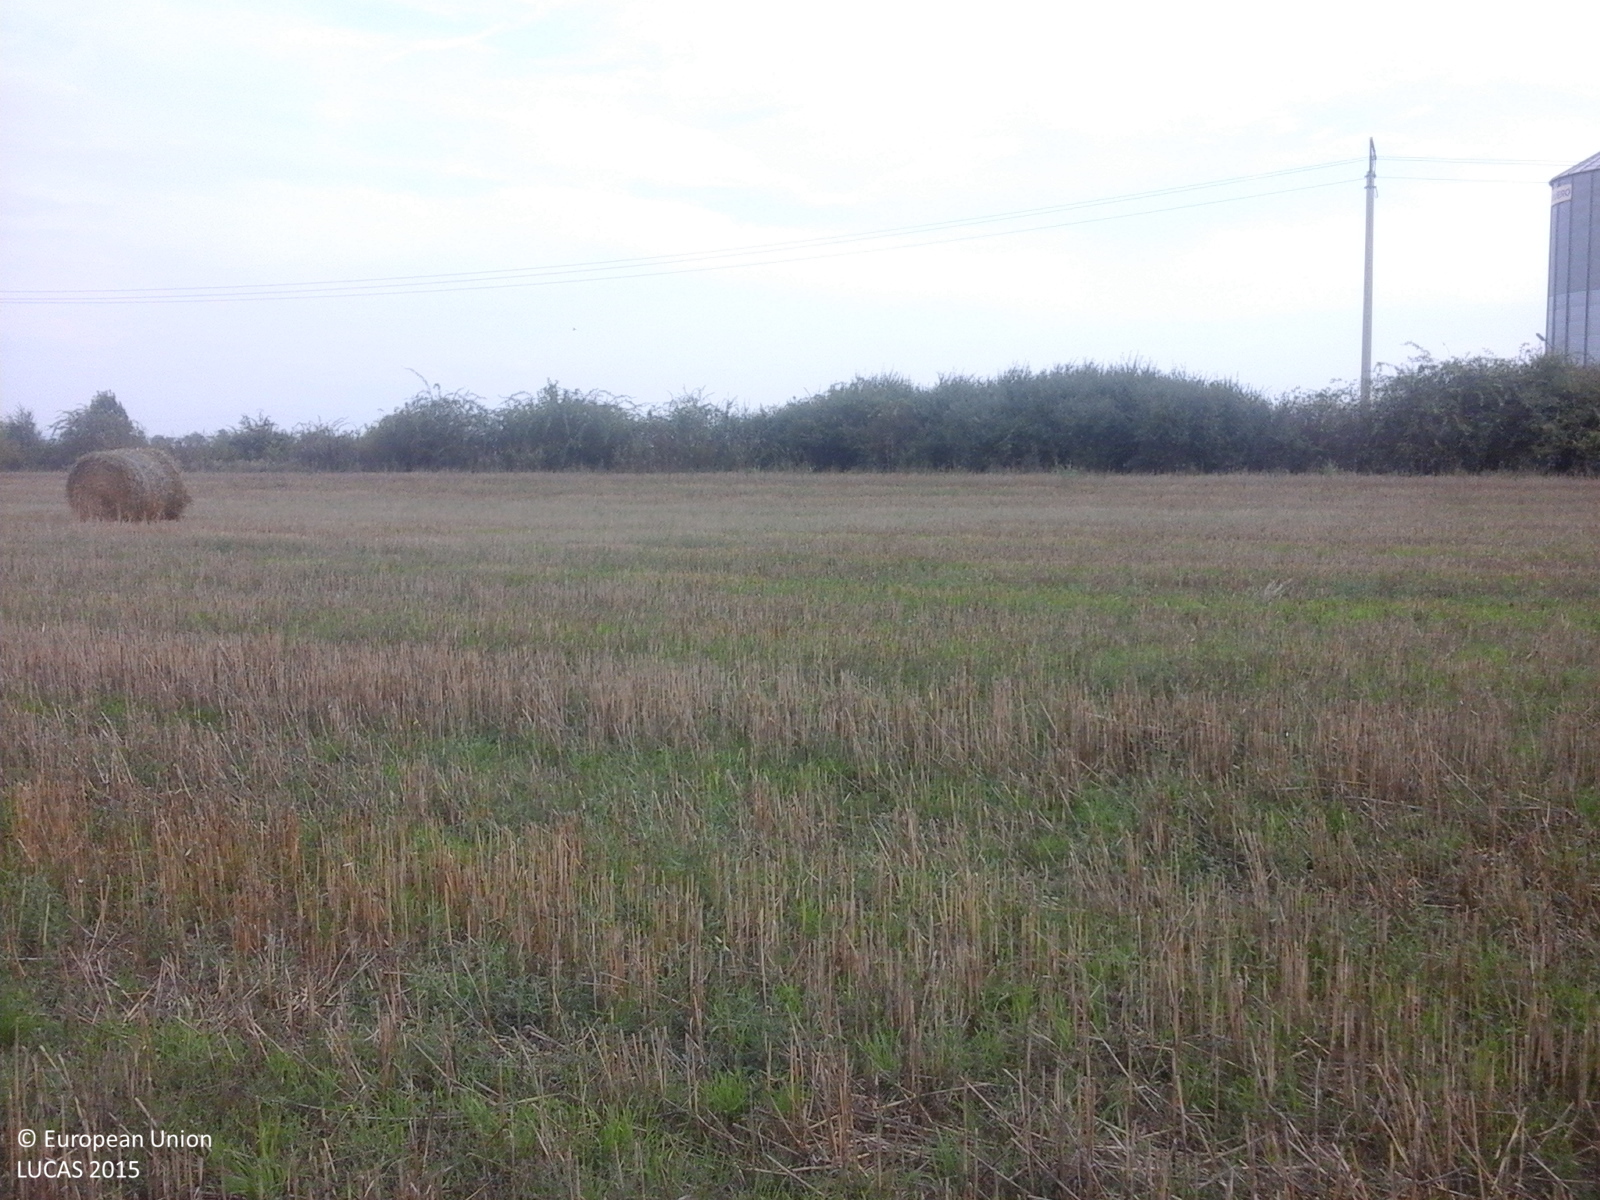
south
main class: Cropland
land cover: Common wheat
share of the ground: 50 - 75 %
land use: Agriculture (excluding fallow land and kitchen gardens)
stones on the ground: < 10 %
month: August
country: RO
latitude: 46.3569
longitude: 21.4076
